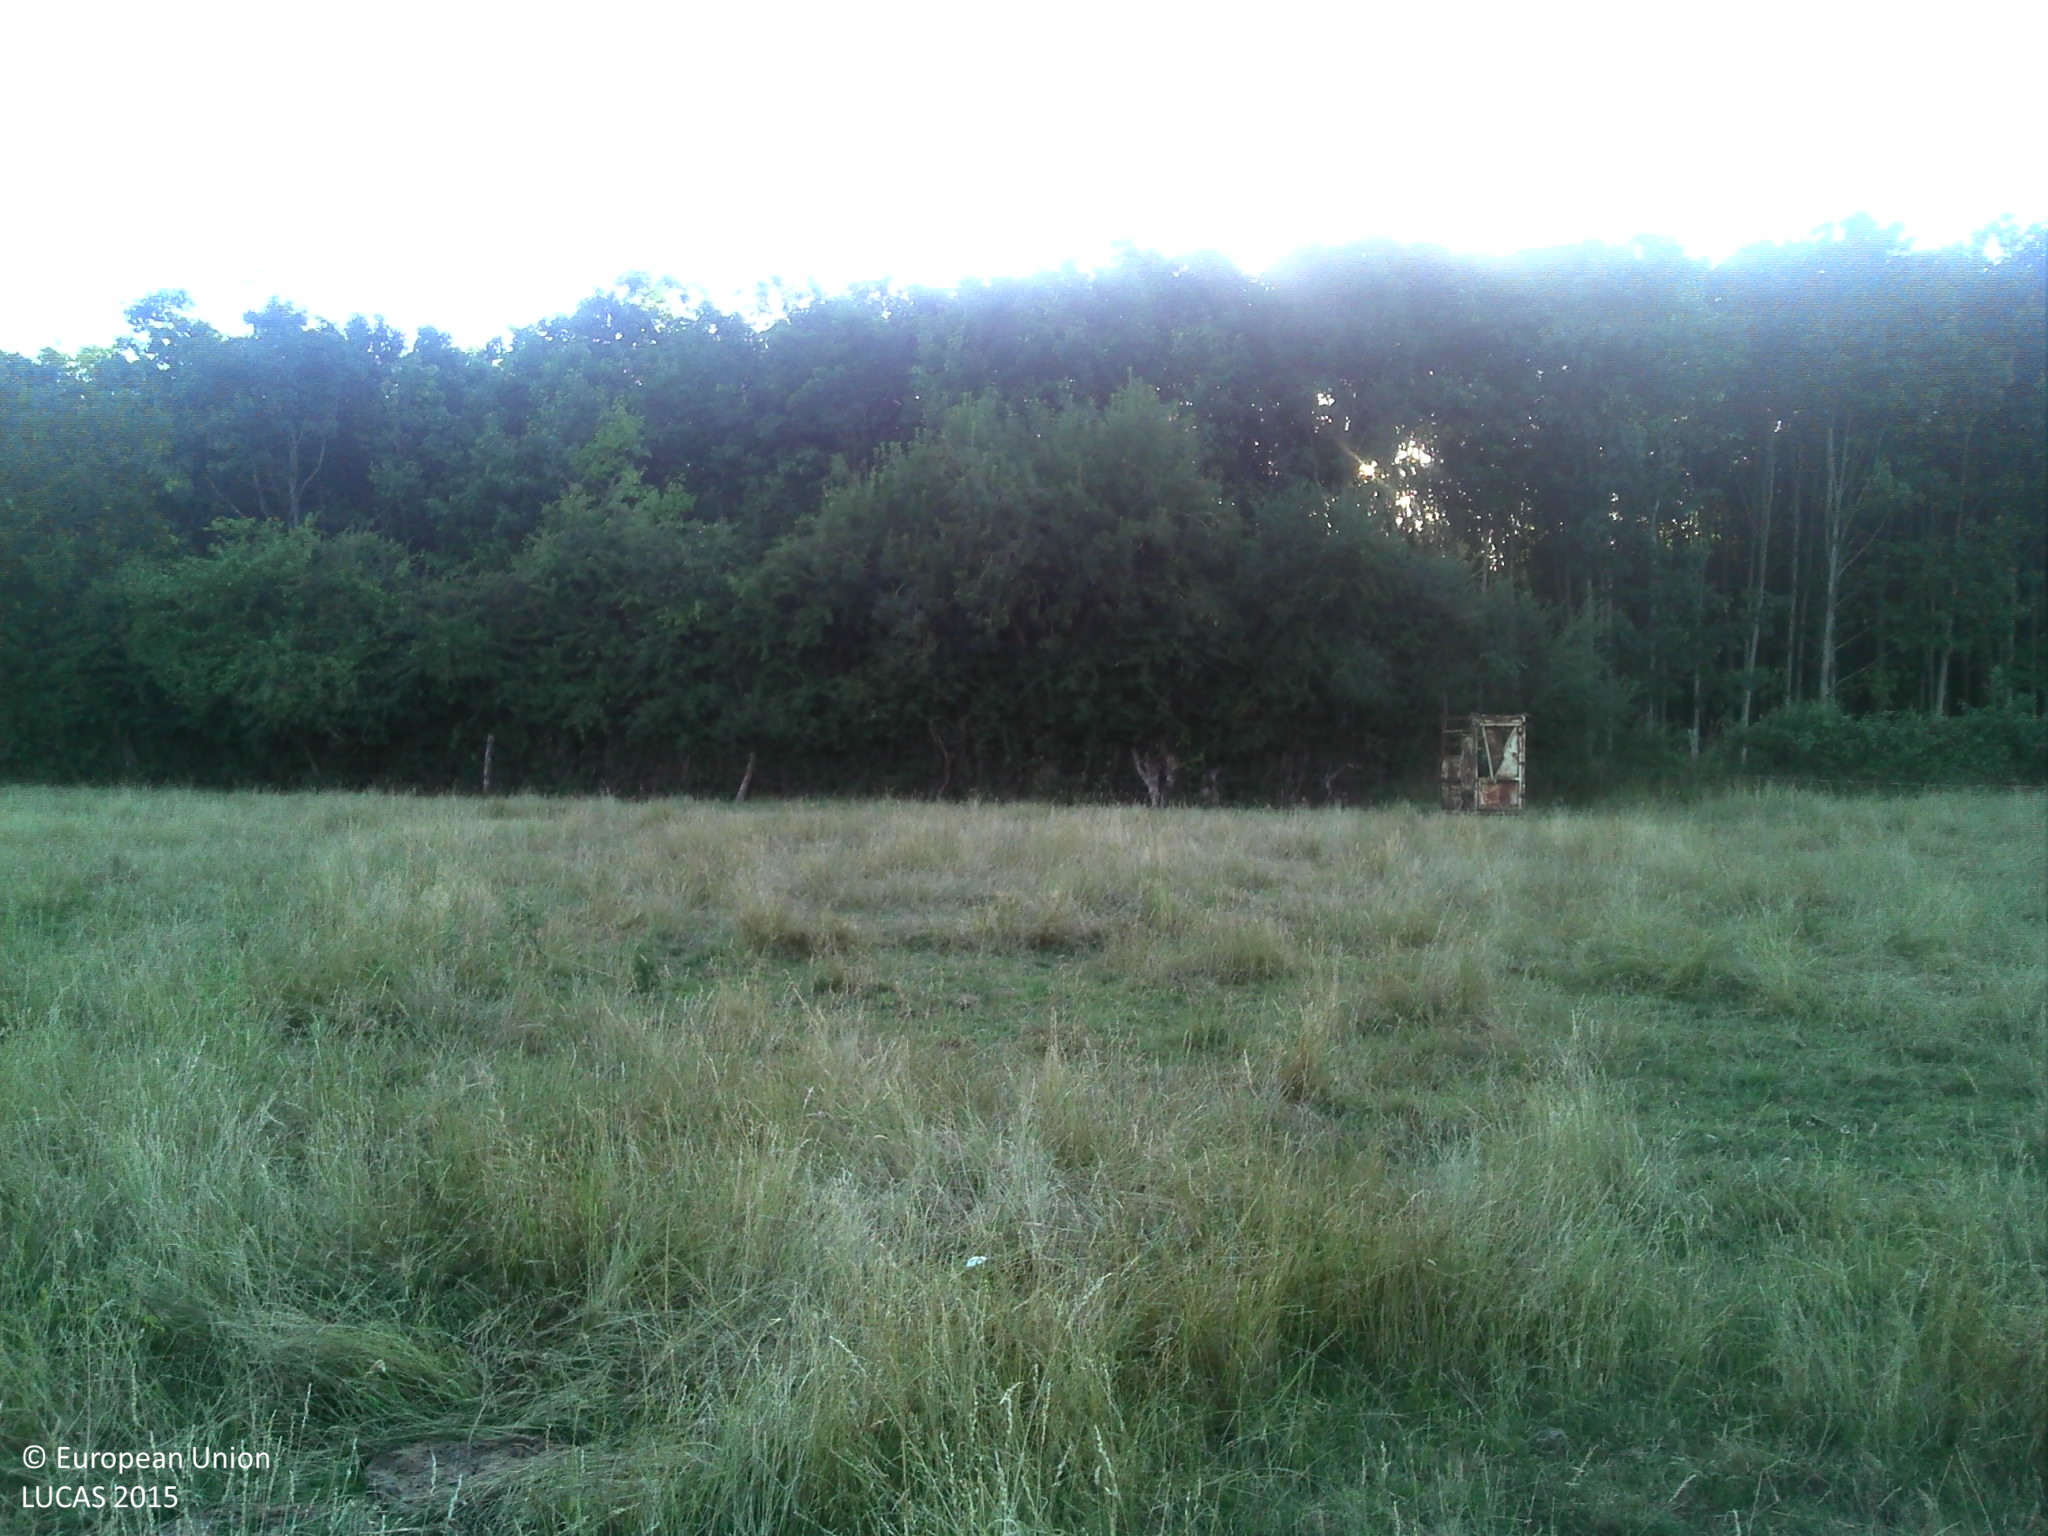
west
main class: Grassland
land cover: Grassland without tree/shrub cover
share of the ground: > 75 %
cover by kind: herbaceous plants 100 %
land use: Agriculture (excluding fallow land and kitchen gardens)
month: July
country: FR
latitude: 48.9016
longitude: 0.7408
